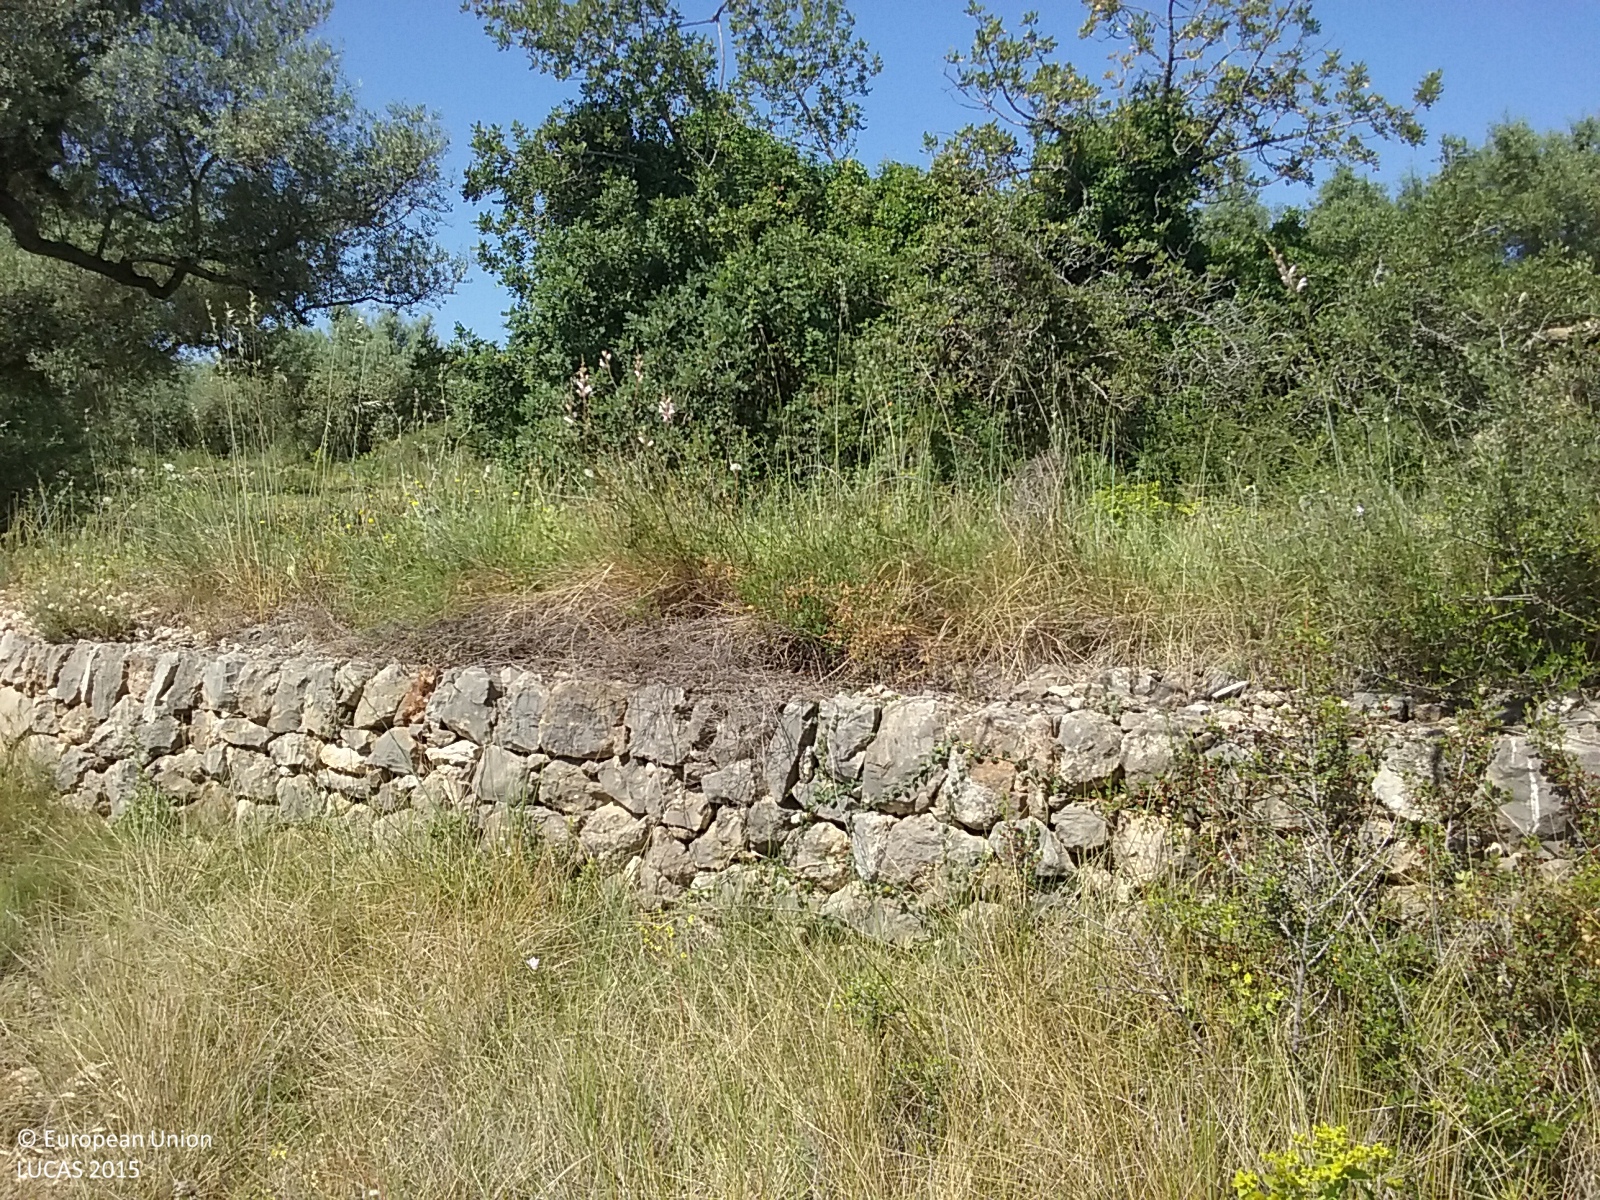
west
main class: Cropland
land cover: Olive groves
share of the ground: 25 - 50 %
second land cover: Grassland without tree/shrub cover
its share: 25 - 50 %
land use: Agriculture (excluding fallow land and kitchen gardens)
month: May
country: ES
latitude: 40.5301
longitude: 0.2797
